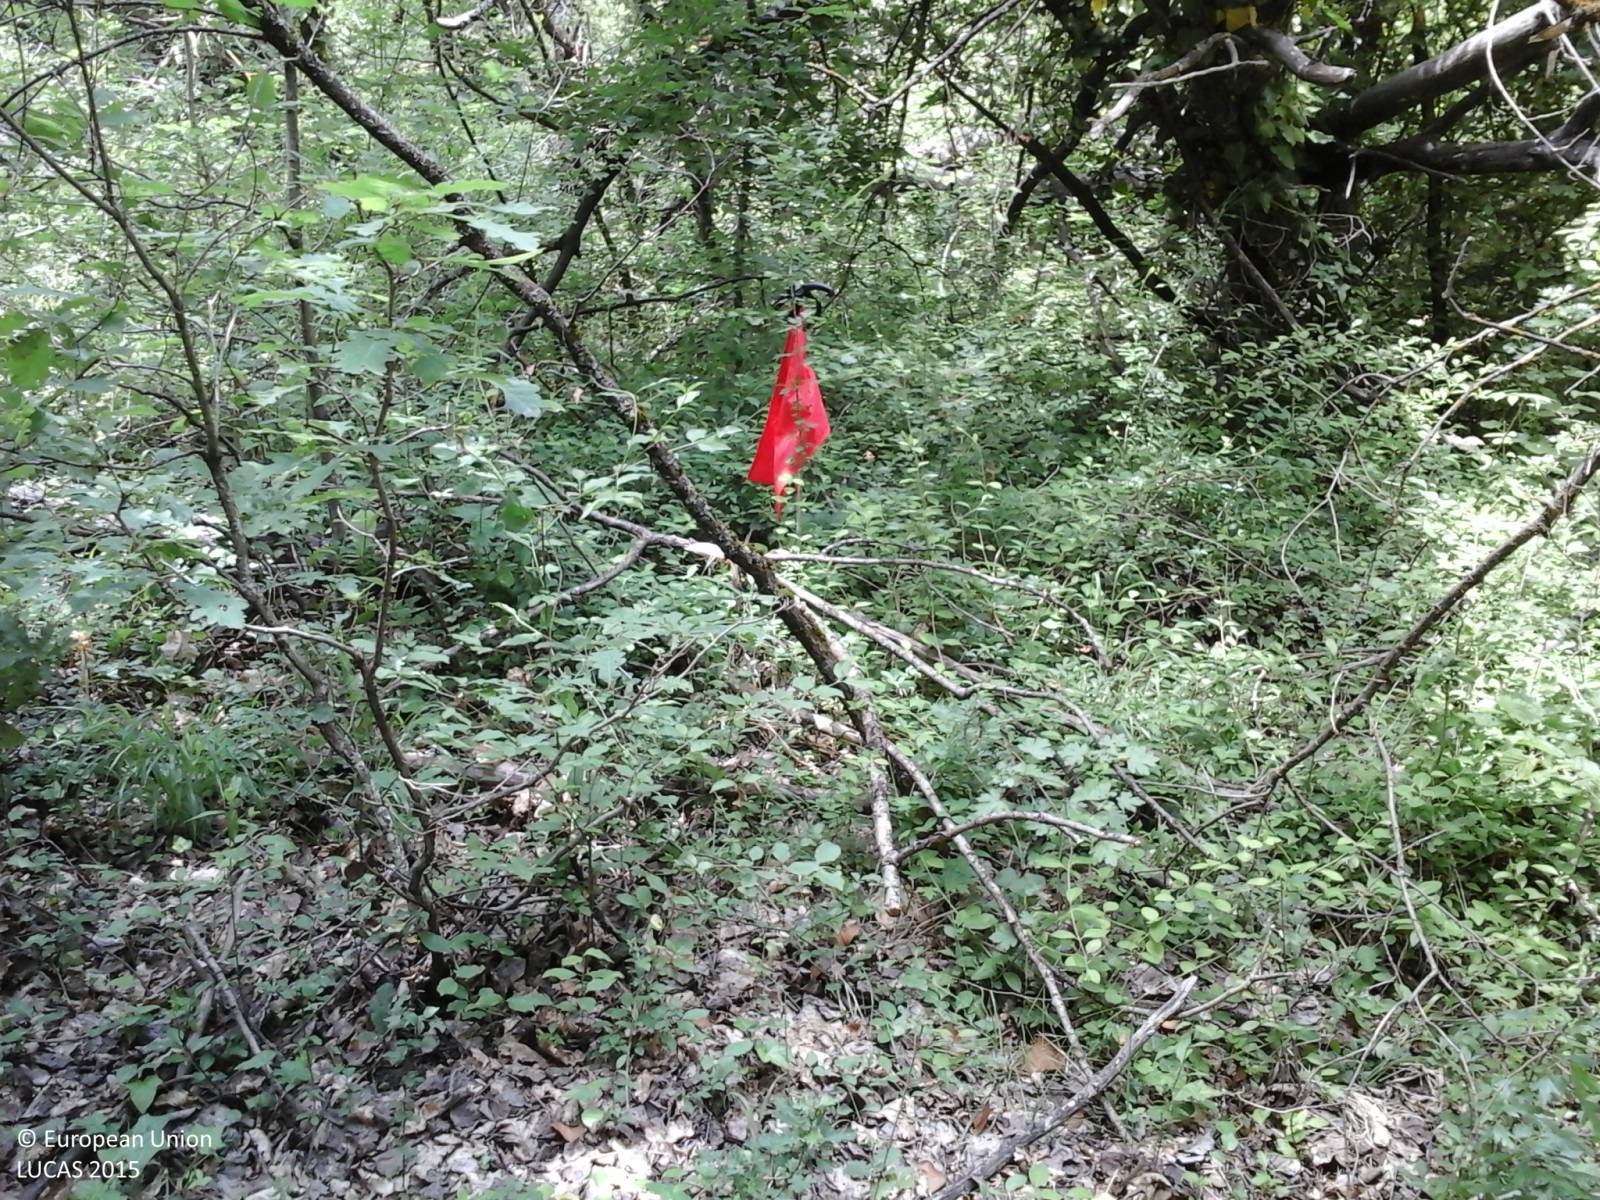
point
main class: Woodland
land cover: Broadleaved woodland
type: thermophilous deciduous forest
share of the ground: > 75 %
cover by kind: broadleaved forest trees 90 %, shrubs 10 %
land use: Forestry
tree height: > 5 m
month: May
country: IT
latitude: 42.0772
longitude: 13.2644
